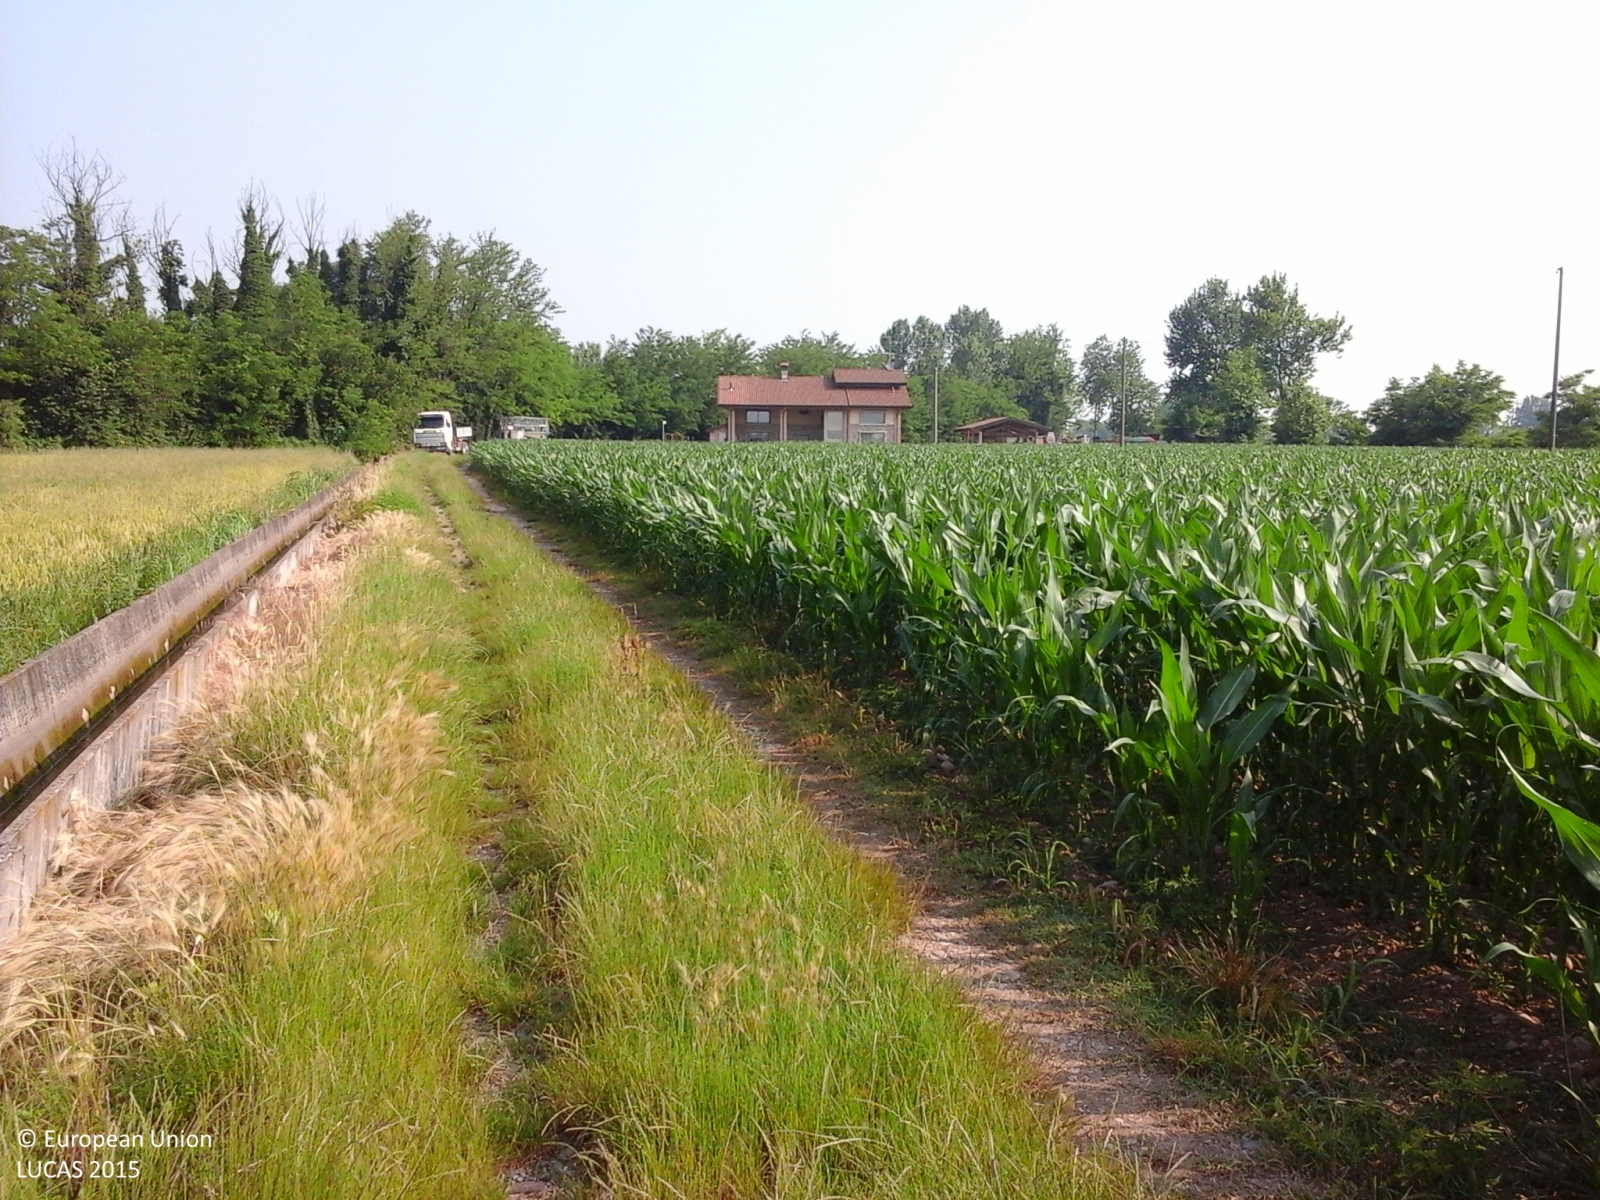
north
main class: Cropland
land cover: Common wheat
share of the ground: > 75 %
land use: Agriculture (excluding fallow land and kitchen gardens)
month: June
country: IT
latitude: 45.4683
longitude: 9.8595
